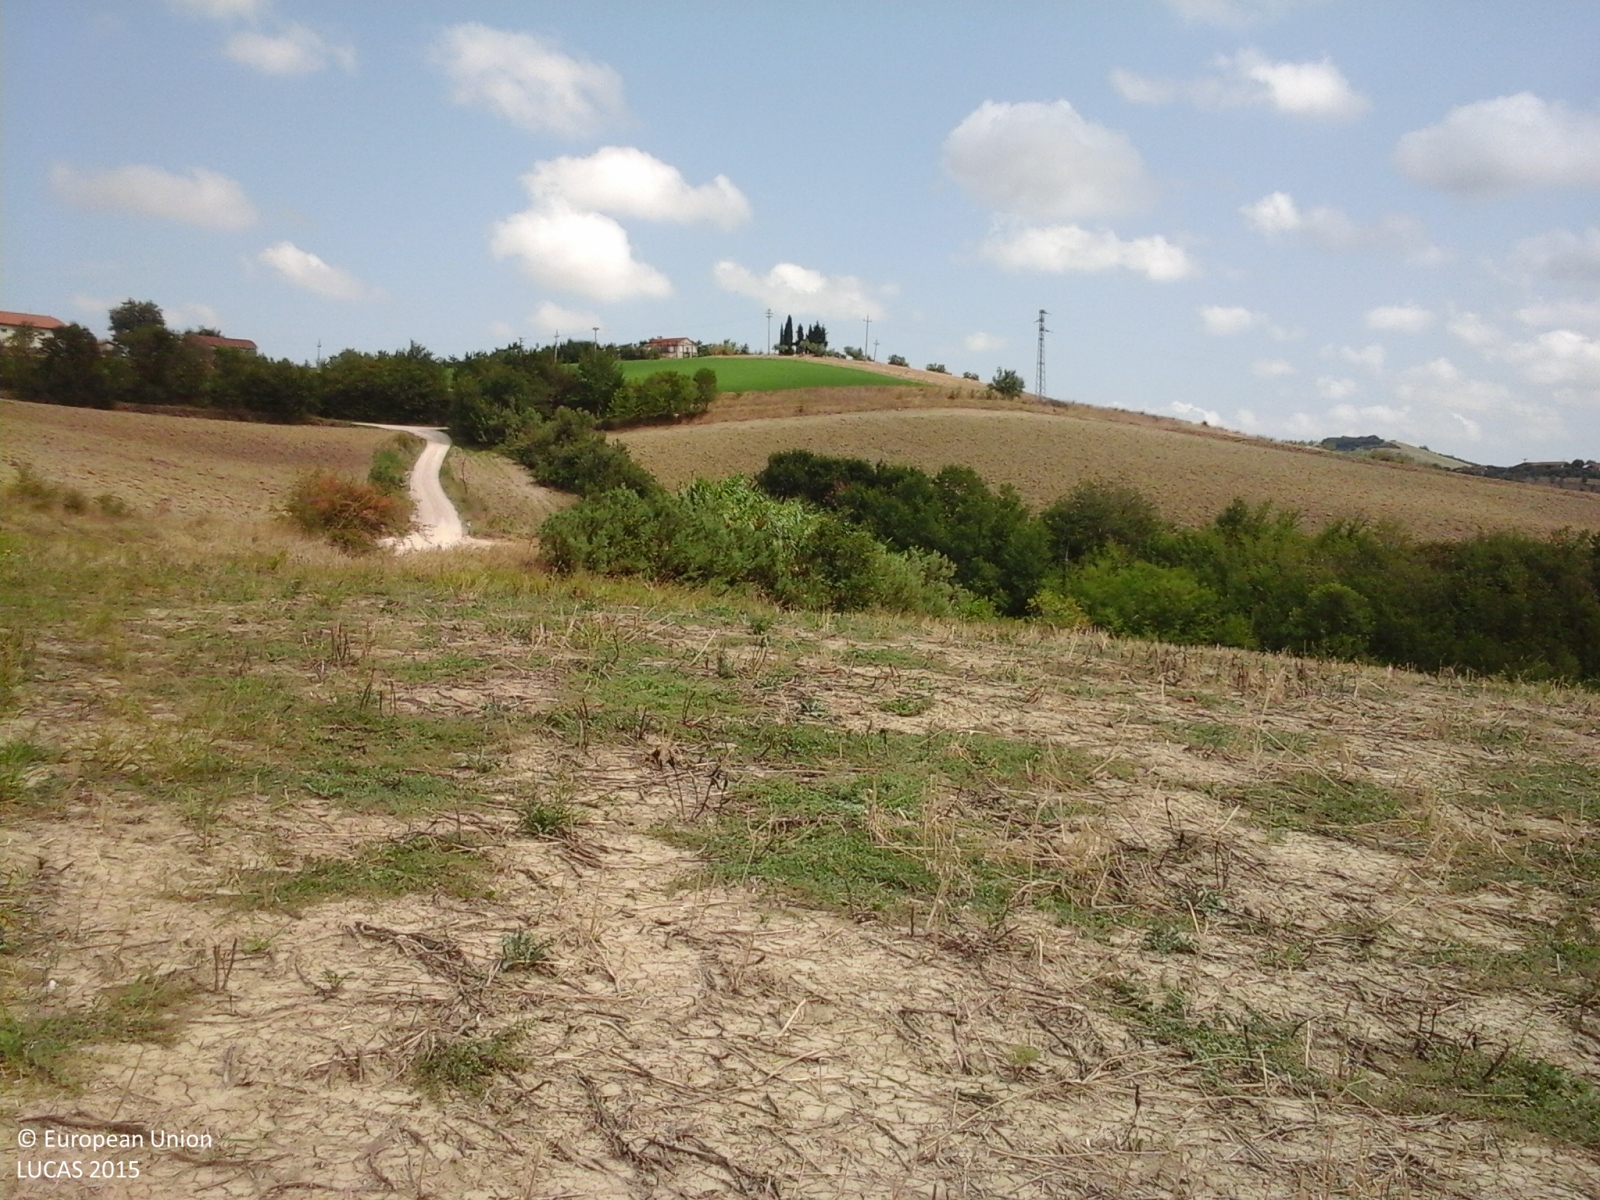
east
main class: Cropland
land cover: Dry pulses
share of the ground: < 10 %
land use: Agriculture (excluding fallow land and kitchen gardens)
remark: Harvested field
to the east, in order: Dry pulses; Broadleaved woodland; Ditches and canals; Grass margins; Other bare soil; Broadleaved woodland; Ditches and canals; Broadleaved woodland; Other bare soil; Grass margins; Tracks; Grass margins; Lucerne
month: August
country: IT
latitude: 42.7269
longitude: 13.8117
